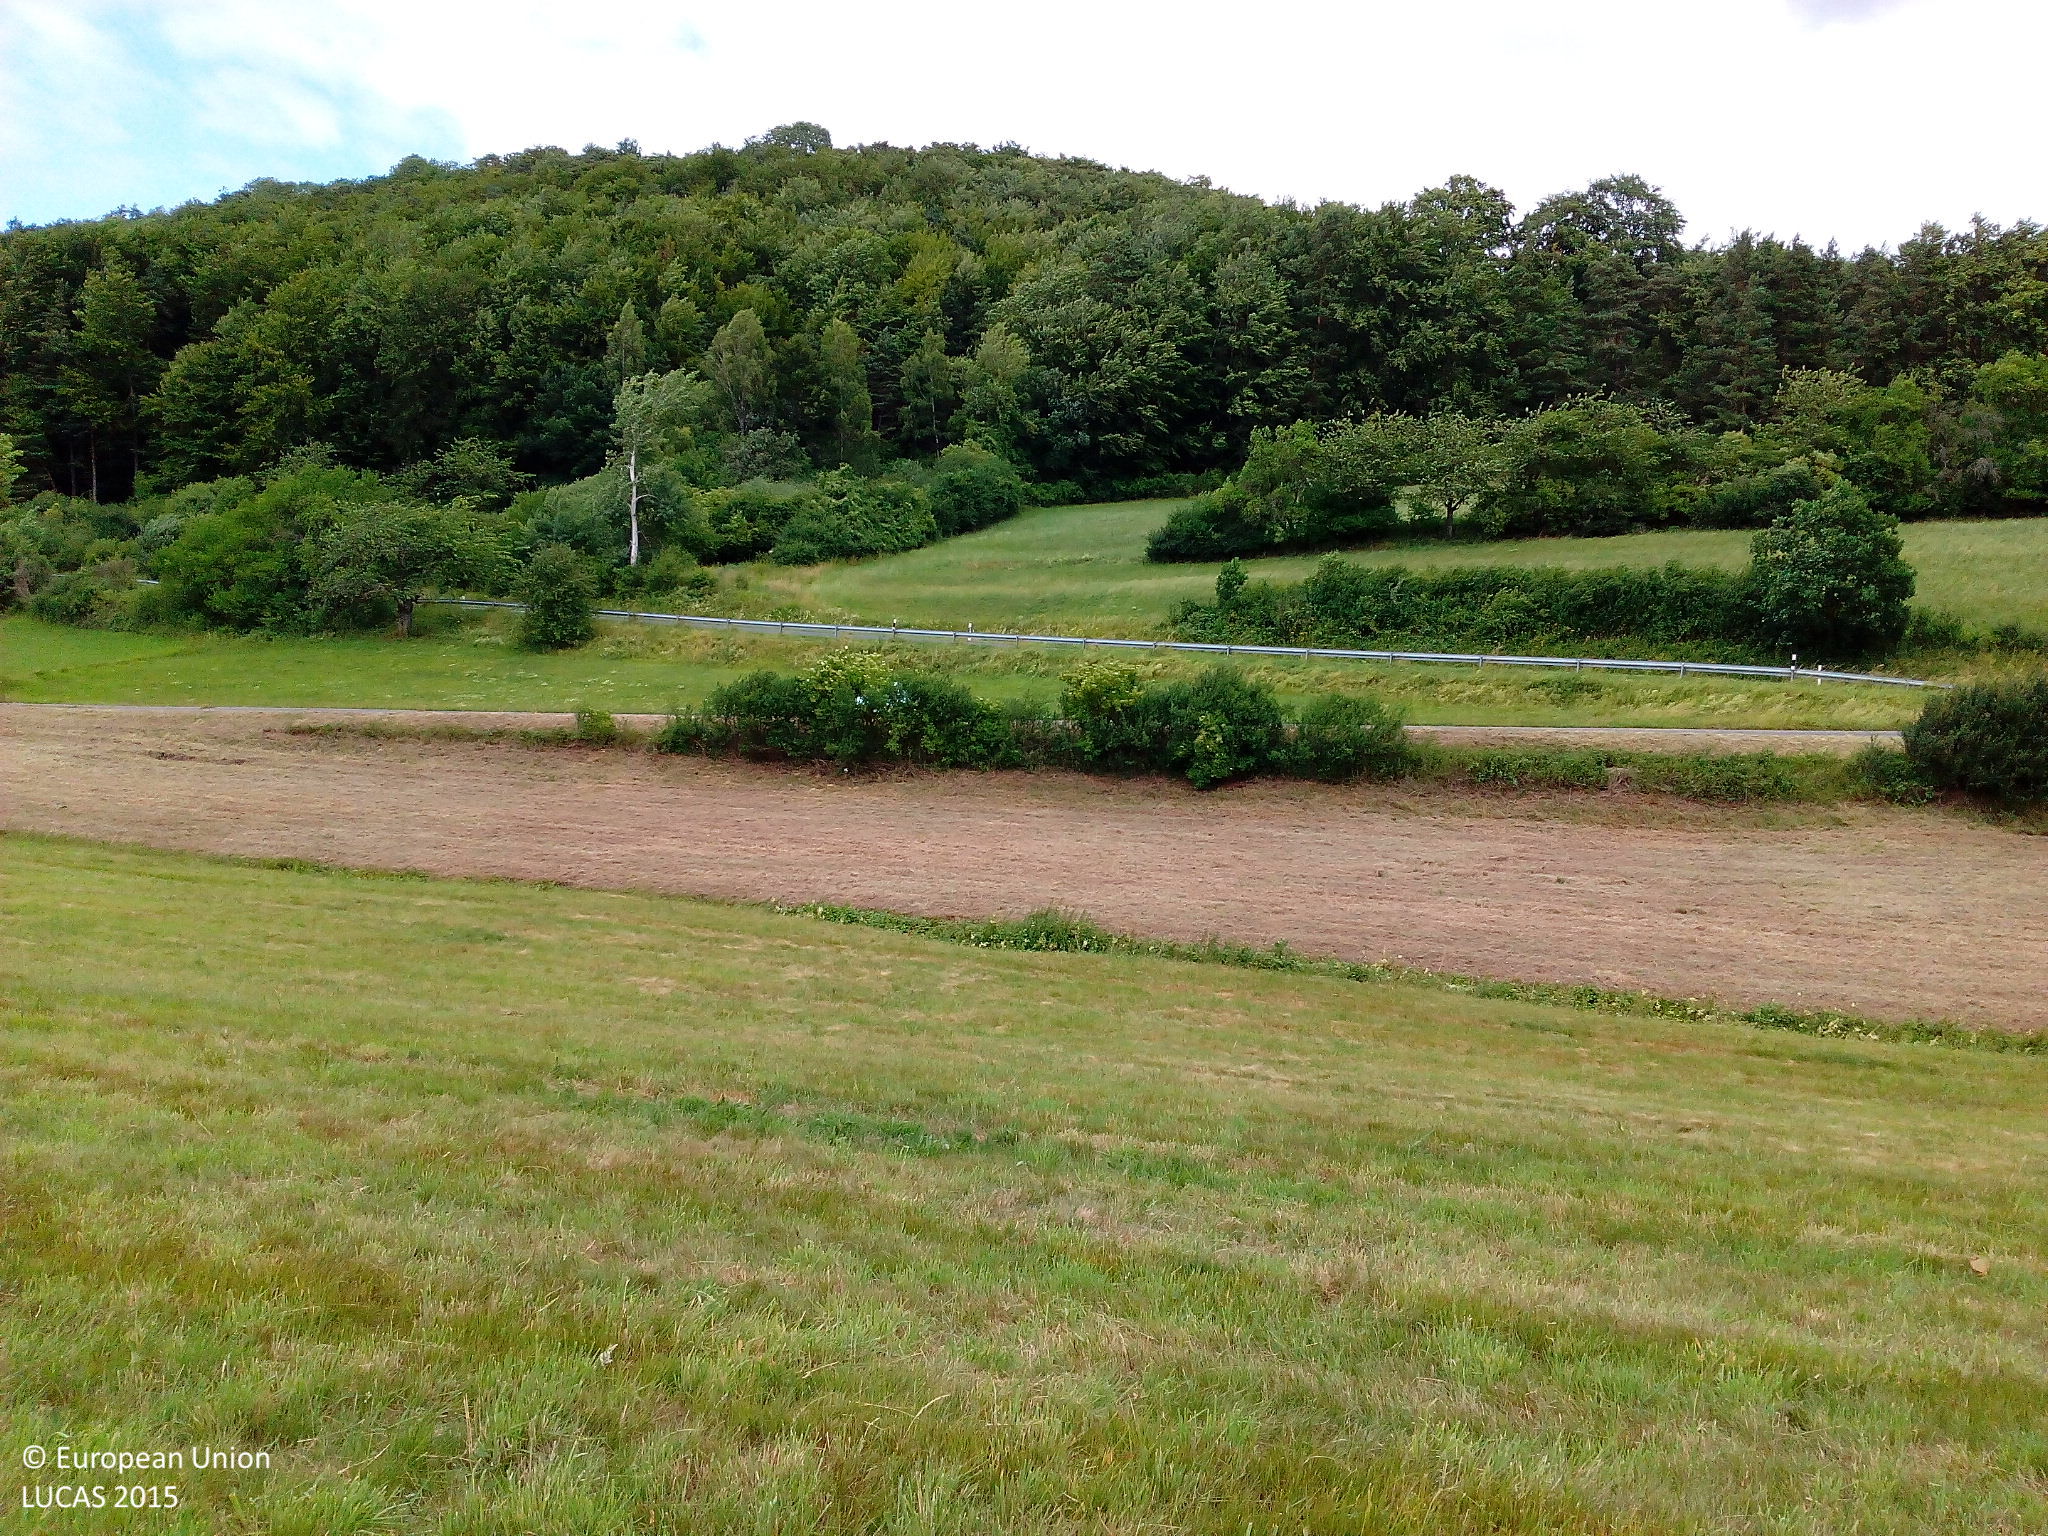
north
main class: Grassland
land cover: Grassland without tree/shrub cover
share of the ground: > 75 %
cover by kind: herbaceous plants 100 %
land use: Agriculture (excluding fallow land and kitchen gardens)
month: July
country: DE
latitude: 51.1011
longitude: 9.8715
